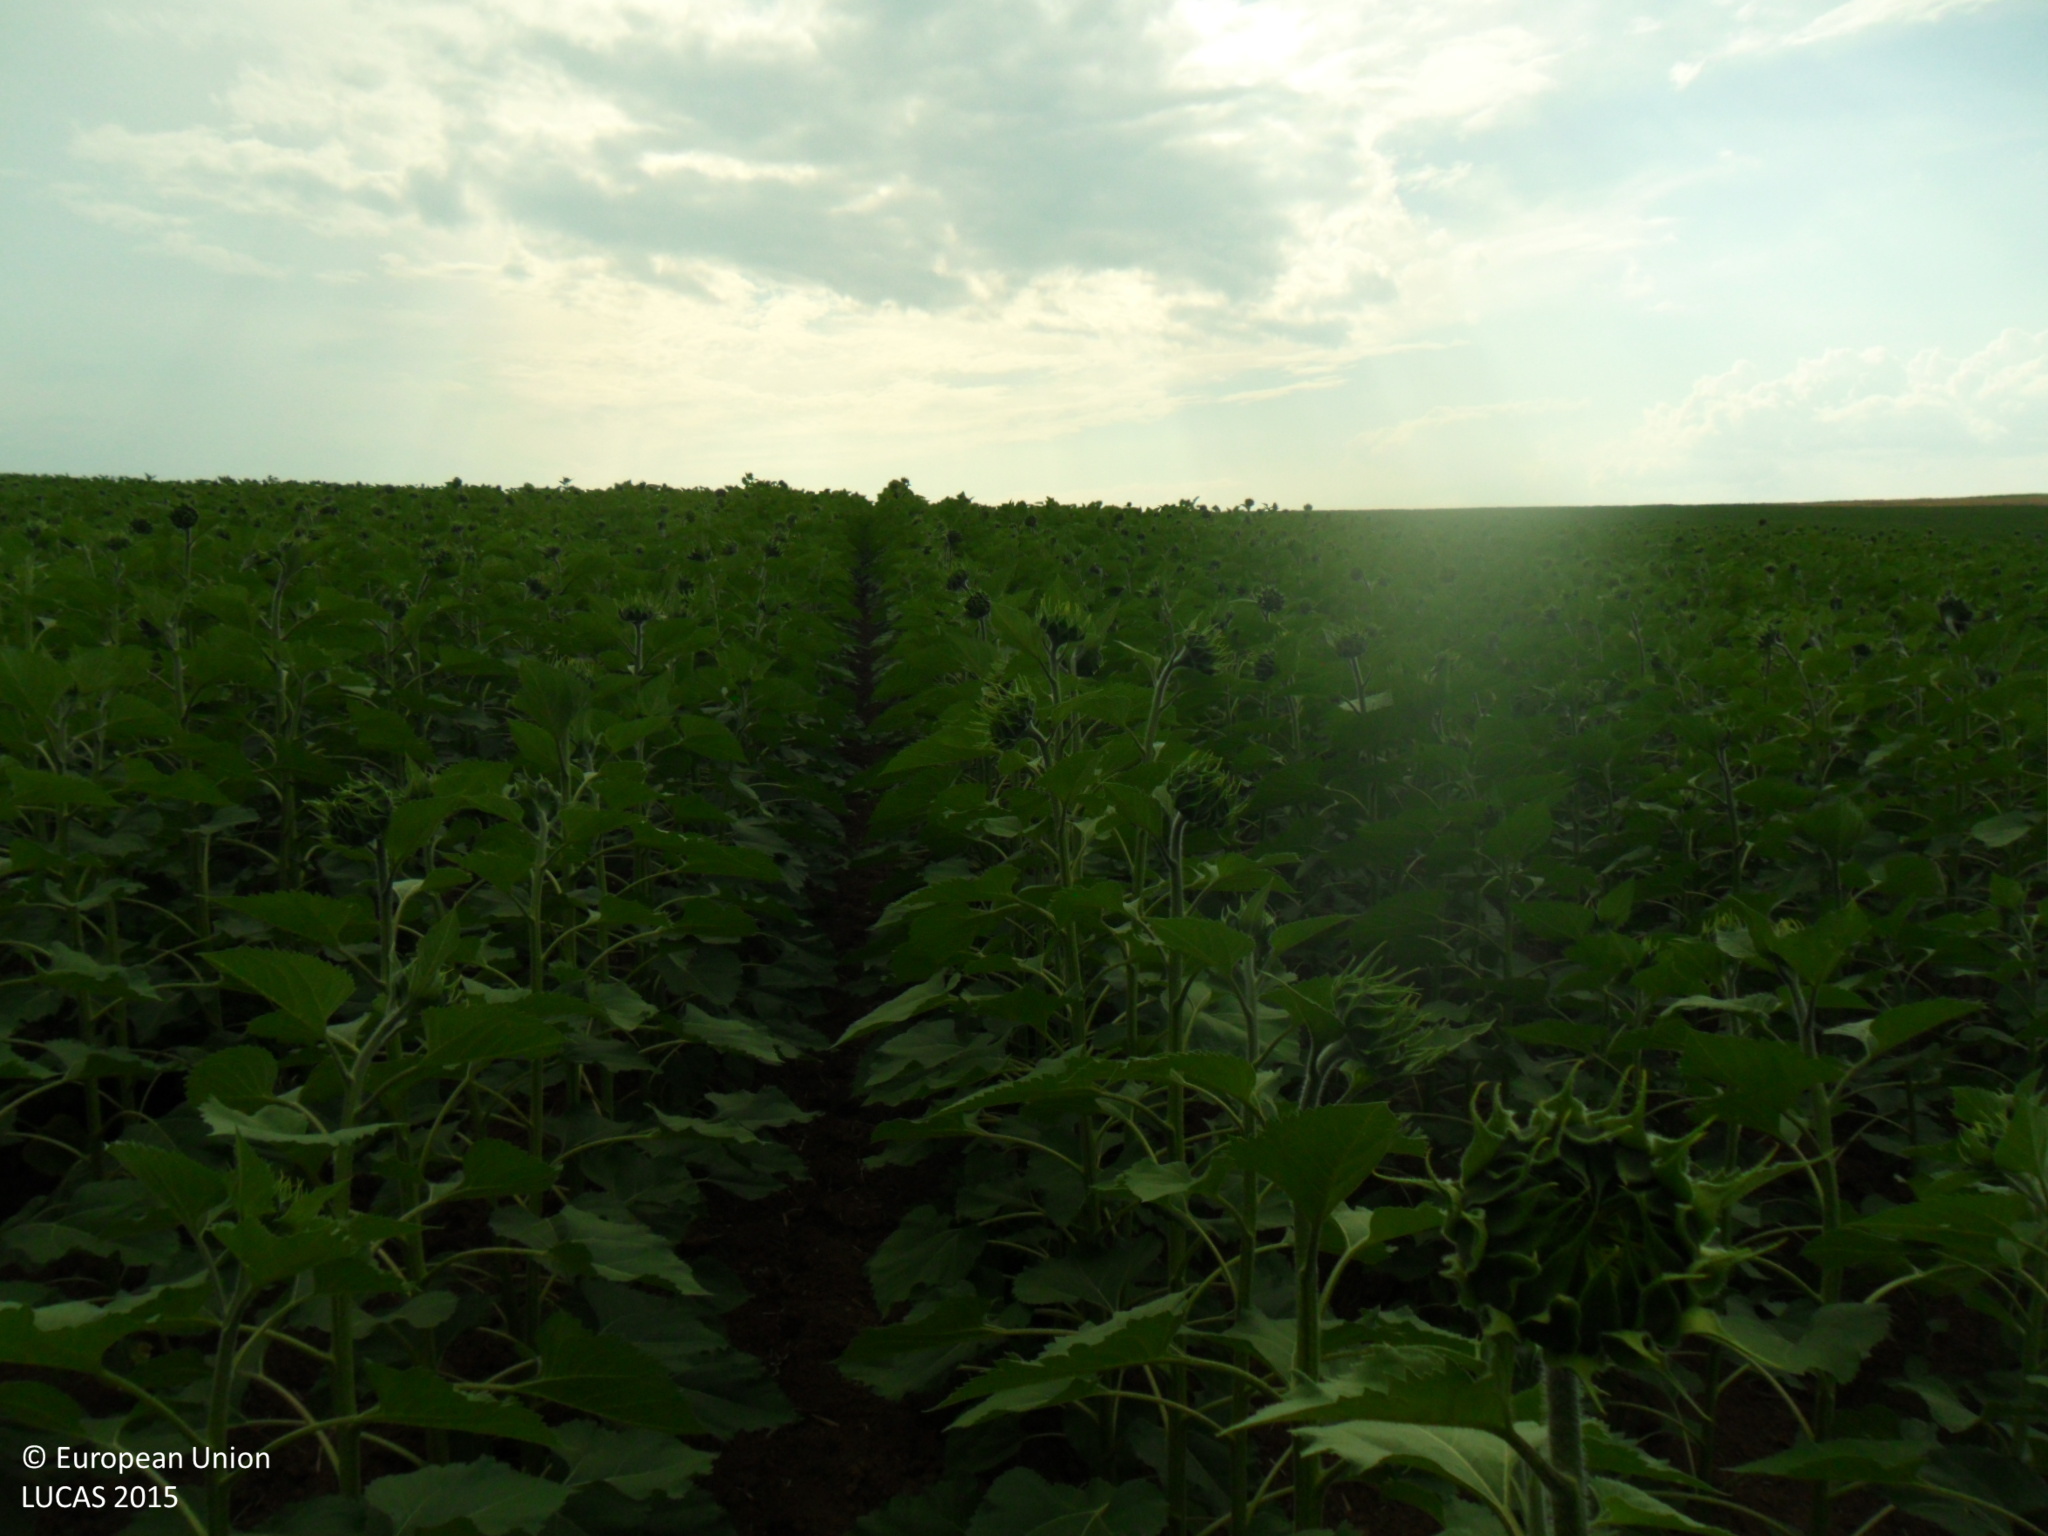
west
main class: Cropland
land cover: Sunflower
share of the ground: > 75 %
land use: Agriculture (excluding fallow land and kitchen gardens)
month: July
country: BG
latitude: 43.6040
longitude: 26.8520
